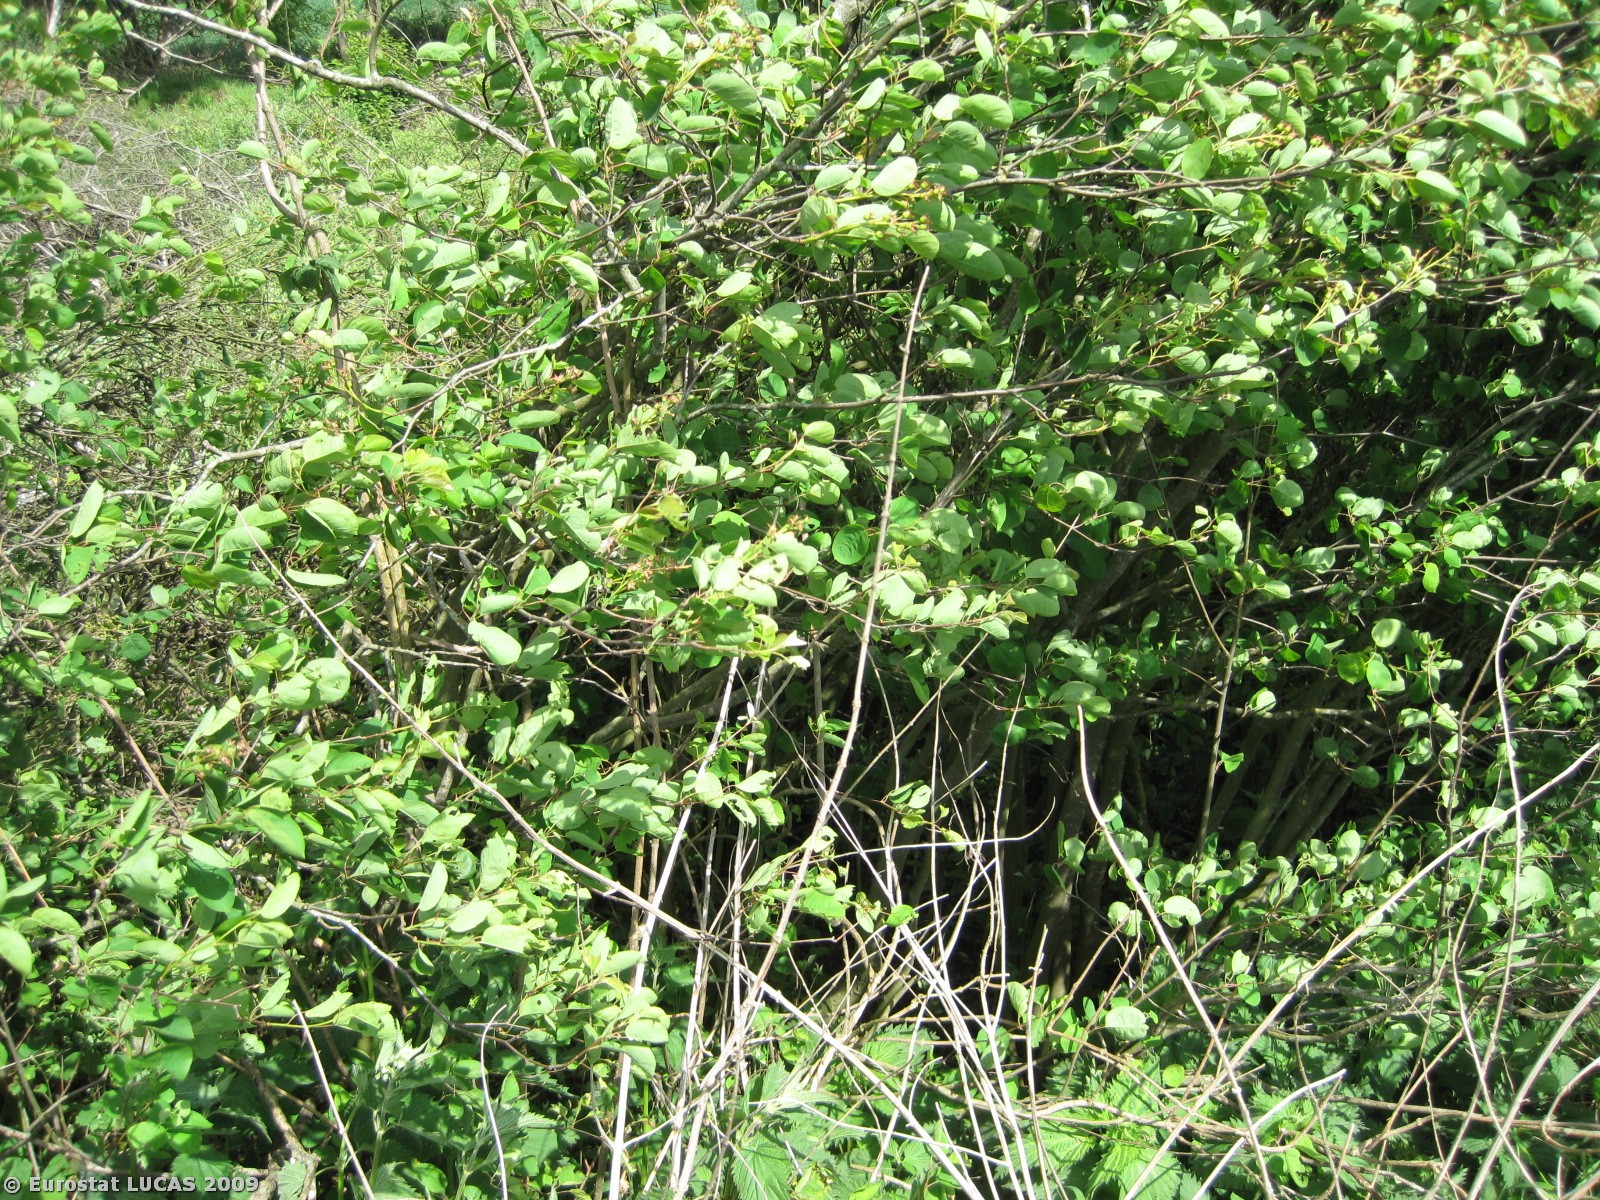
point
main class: Woodland
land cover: Broadleaved woodland
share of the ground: > 75 %
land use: Unused
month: May
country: DK
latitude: 56.7089
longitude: 9.7879
